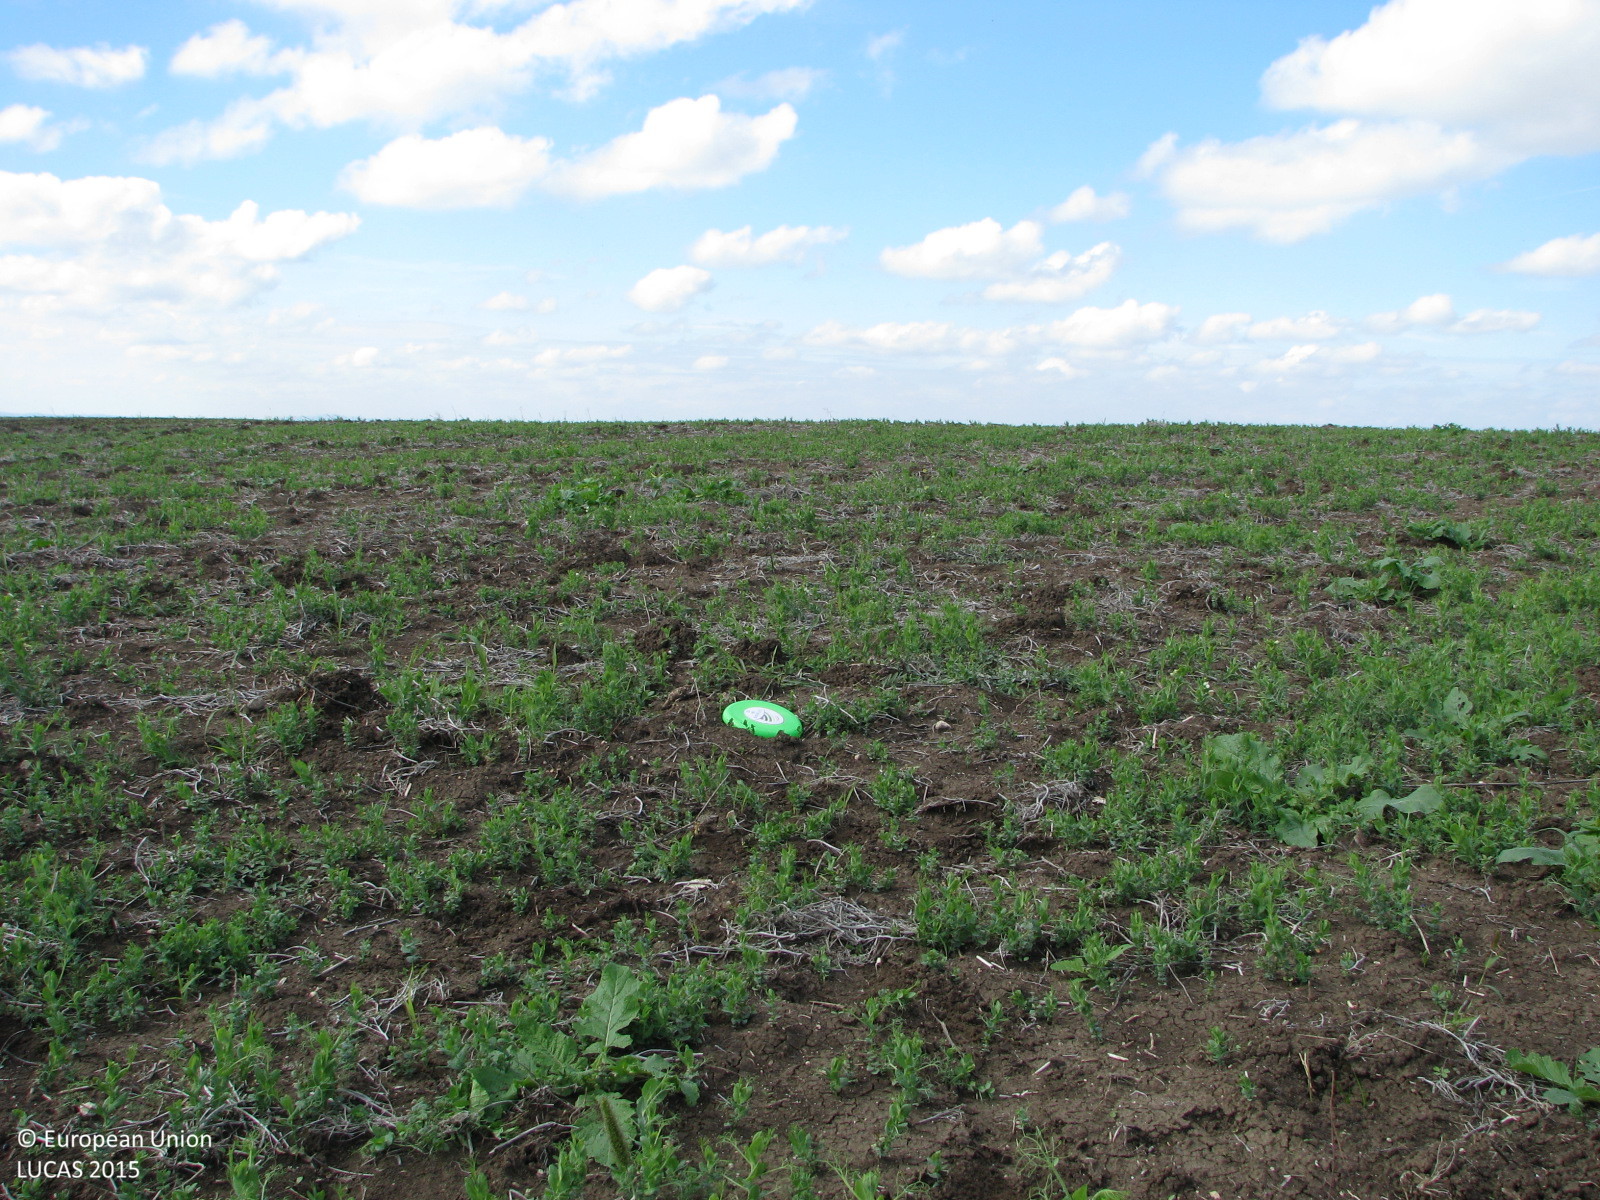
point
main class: Grassland
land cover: Spontaneously vegetated surfaces
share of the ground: 25 - 50 %
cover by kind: unconsolidated bare surface 60 %, herbaceous plants 40 %
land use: Agriculture (excluding fallow land and kitchen gardens)
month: October
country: BG
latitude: 42.3772
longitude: 26.5978
